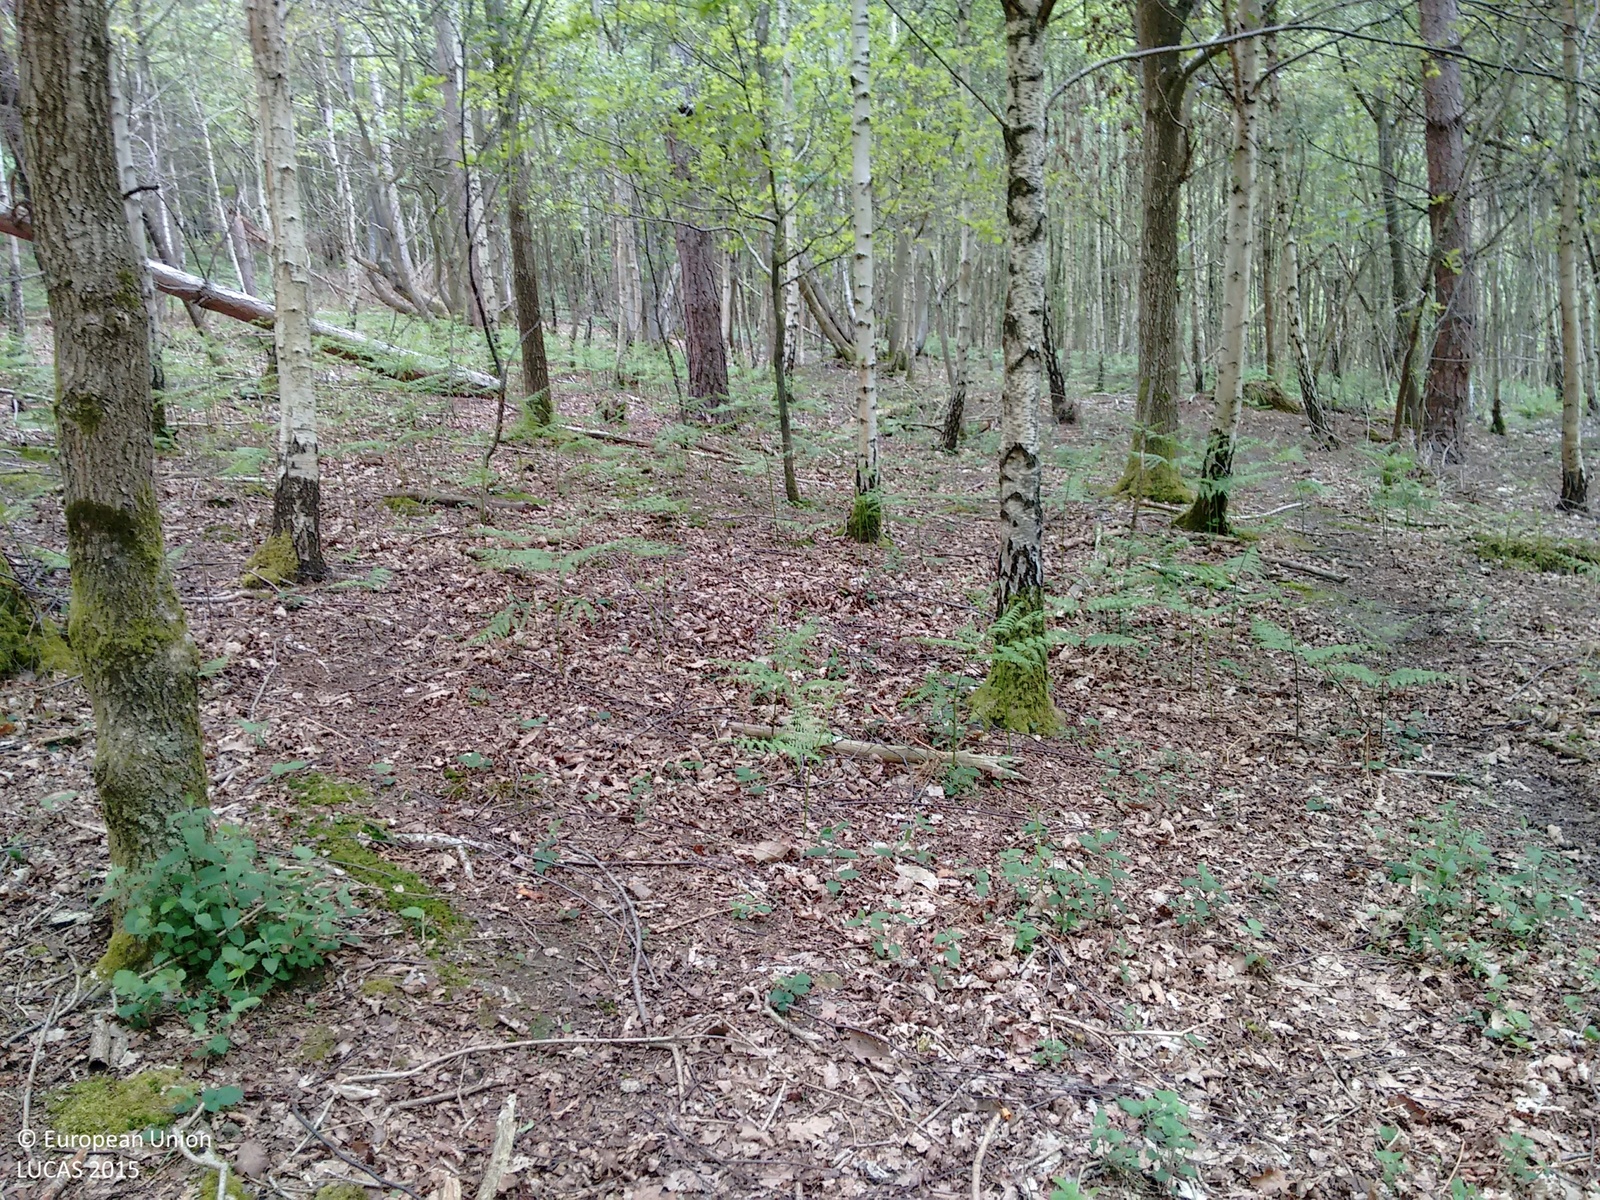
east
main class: Woodland
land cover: Broadleaved woodland
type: mesophytic deciduous forest
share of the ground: > 75 %
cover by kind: broadleaved forest trees 95 %, coniferous forest trees 5 %
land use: Forestry
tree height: > 5 m
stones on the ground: < 10 %
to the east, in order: Broadleaved woodland; Pine dominated mixed woodland
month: May
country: GB
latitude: 51.1125
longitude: 0.3286
